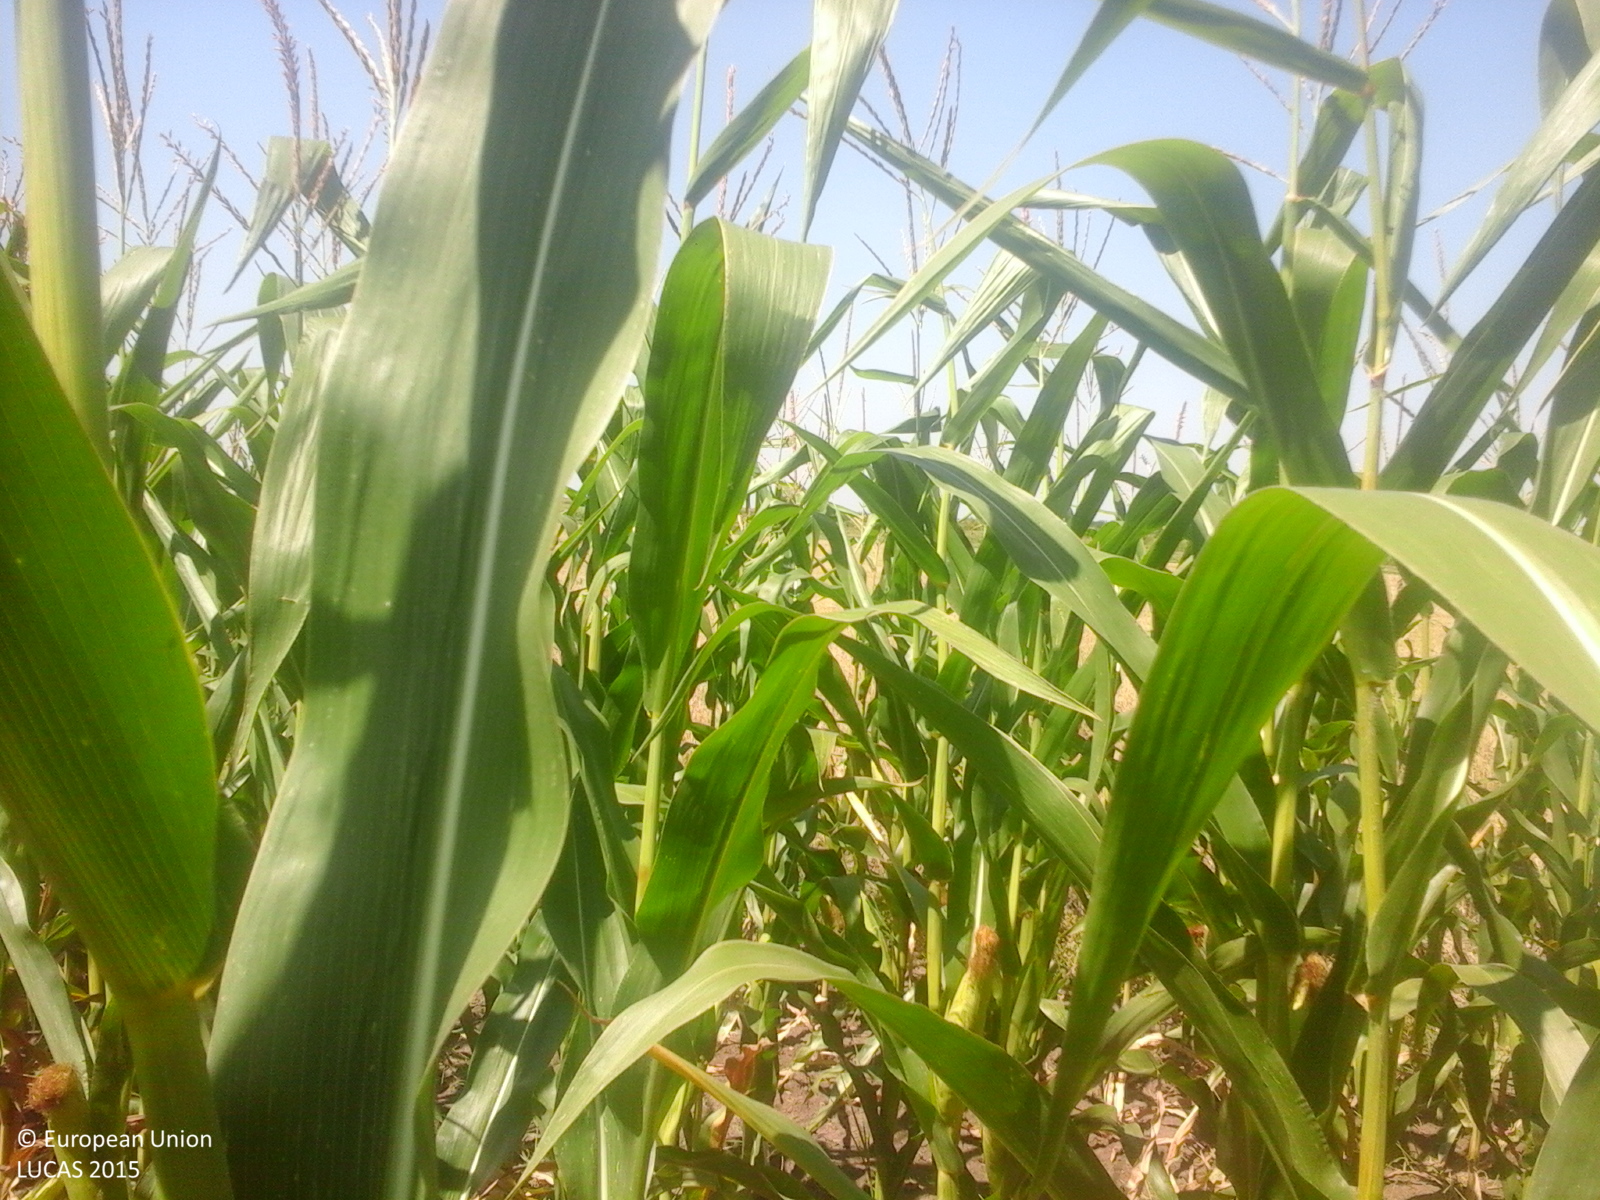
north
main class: Cropland
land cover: Maize
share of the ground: > 75 %
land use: Agriculture (excluding fallow land and kitchen gardens)
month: July
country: RO
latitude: 44.3694
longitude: 26.6708
